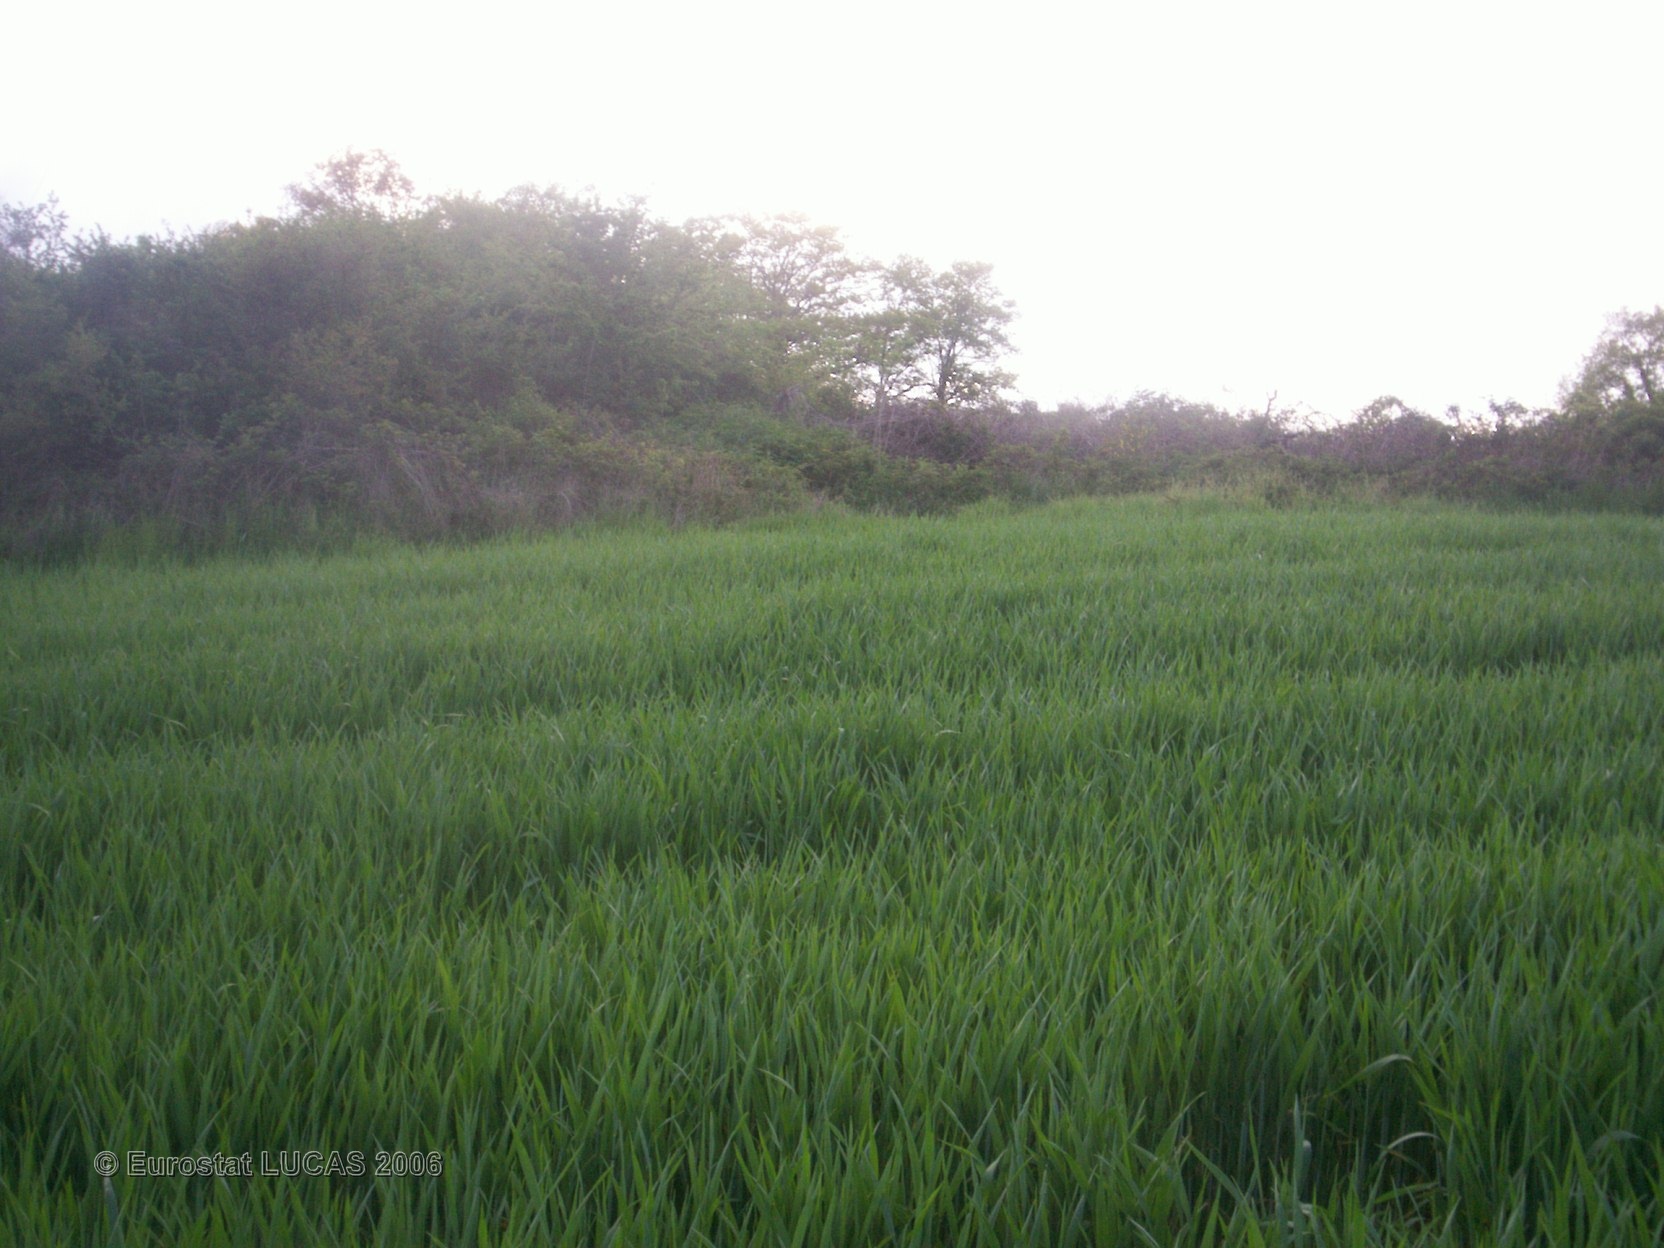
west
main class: Cropland
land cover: Common wheat
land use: Agriculture (excluding fallow land and kitchen gardens)
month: May
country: FR
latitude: 46.0174
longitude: 3.0627
